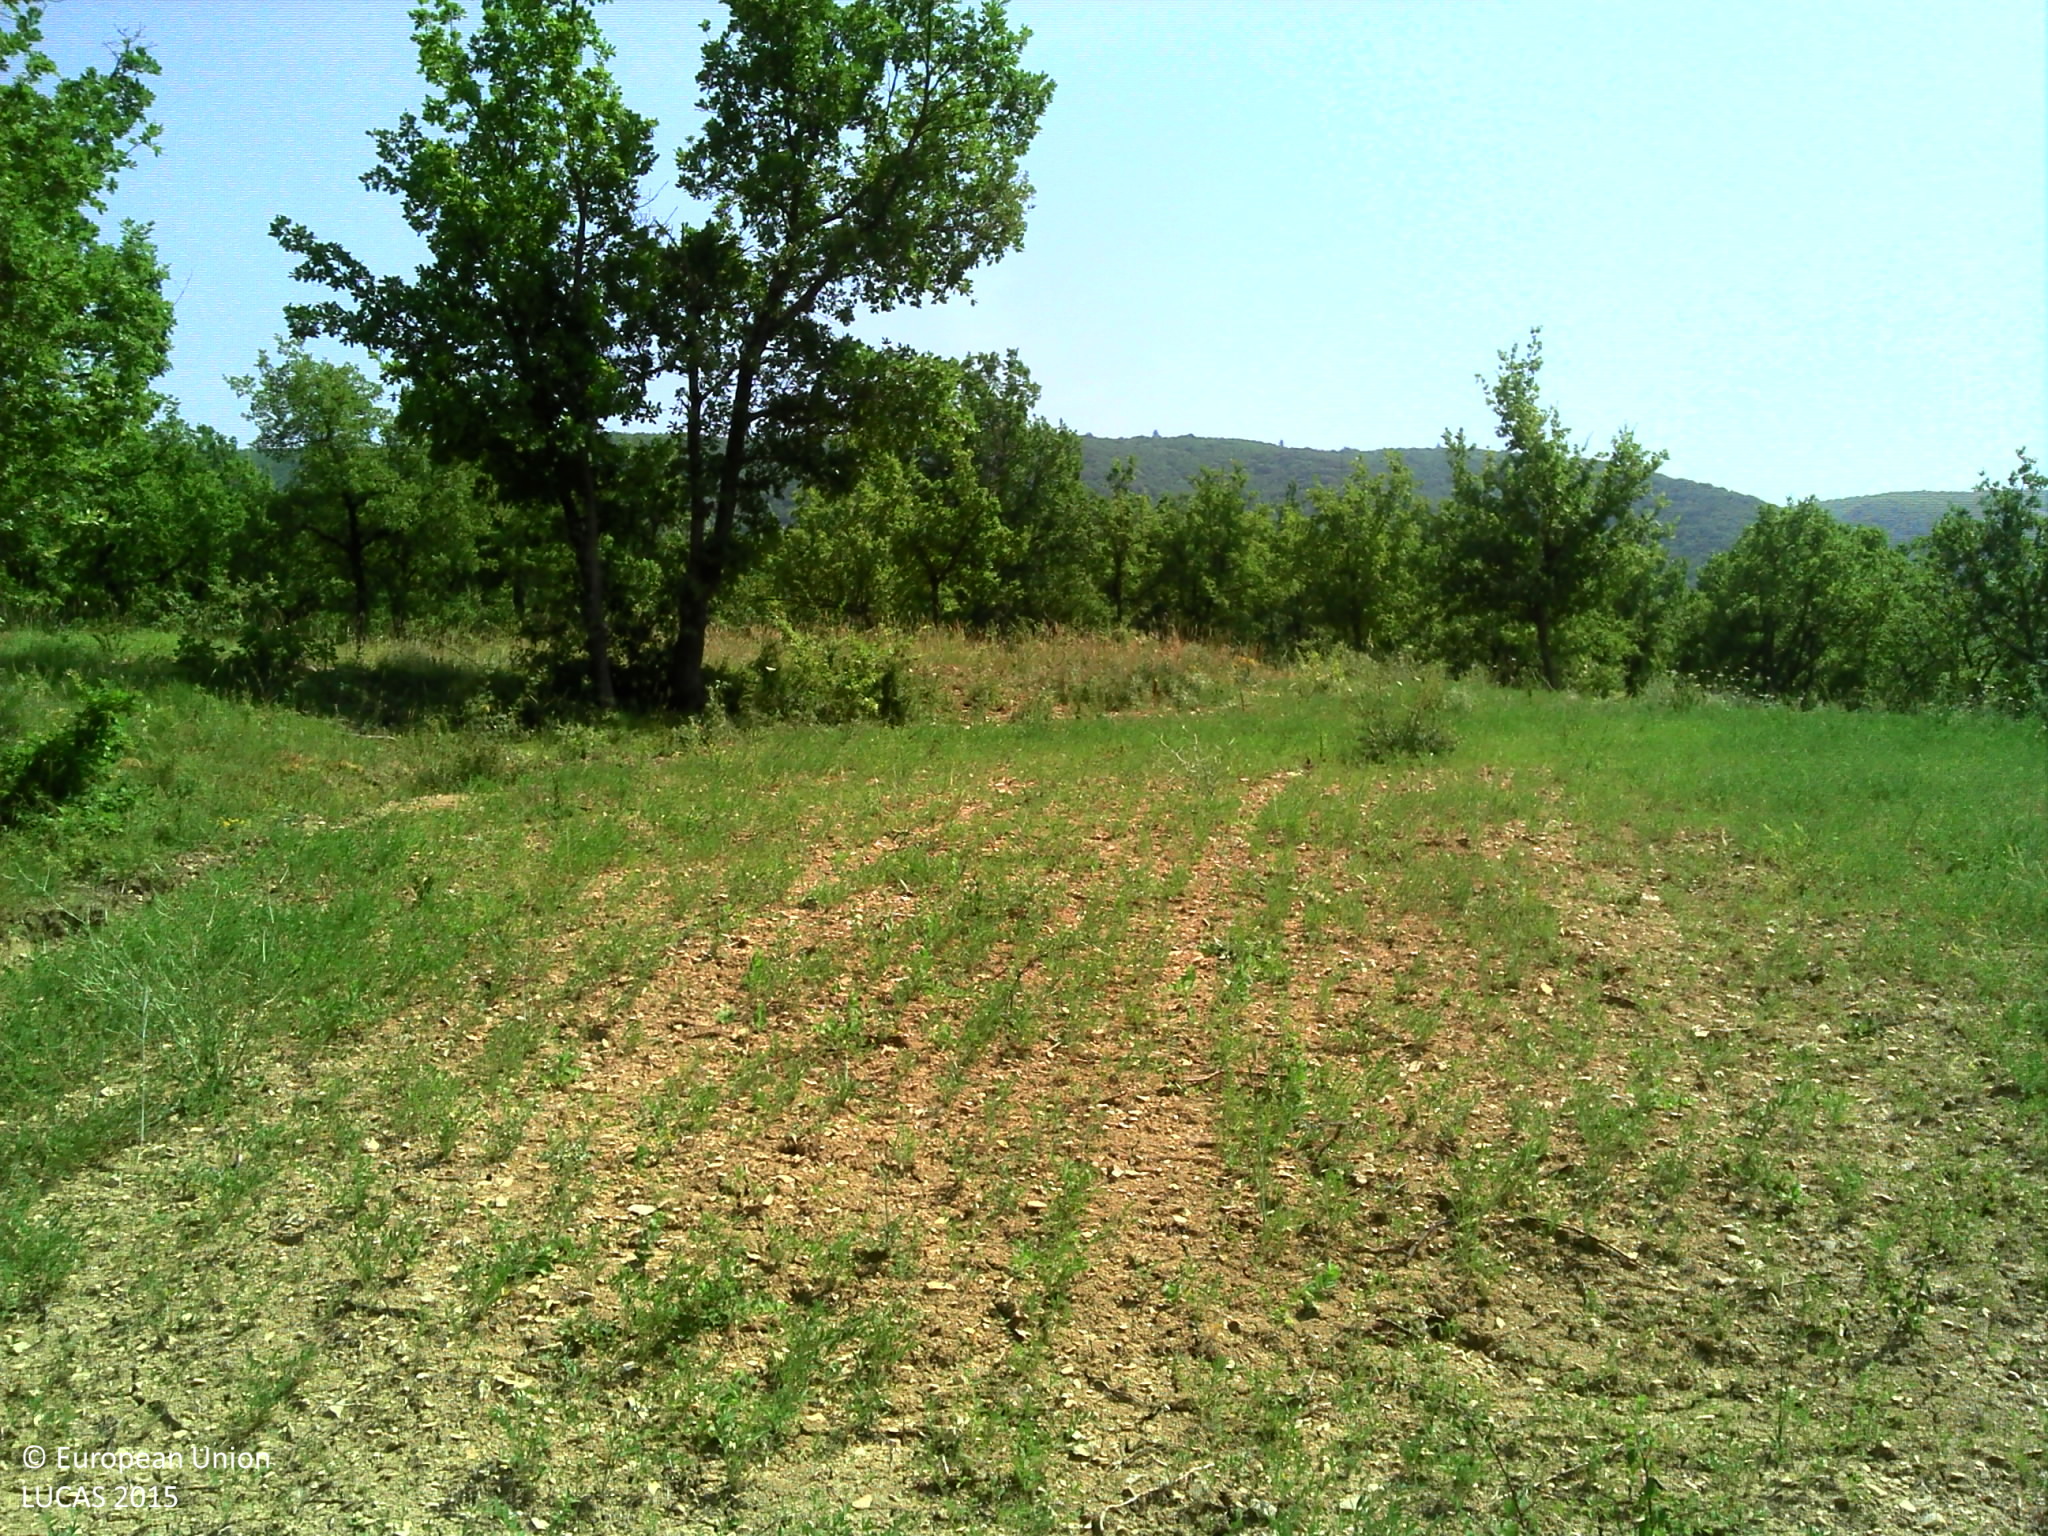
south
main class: Grassland
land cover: Spontaneously vegetated surfaces
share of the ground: > 75 %
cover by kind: herbaceous plants 90 %, shrubs 5 %
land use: Semi-natural and natural areas not in use
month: July
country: FR
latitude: 43.8404
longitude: 5.5685
